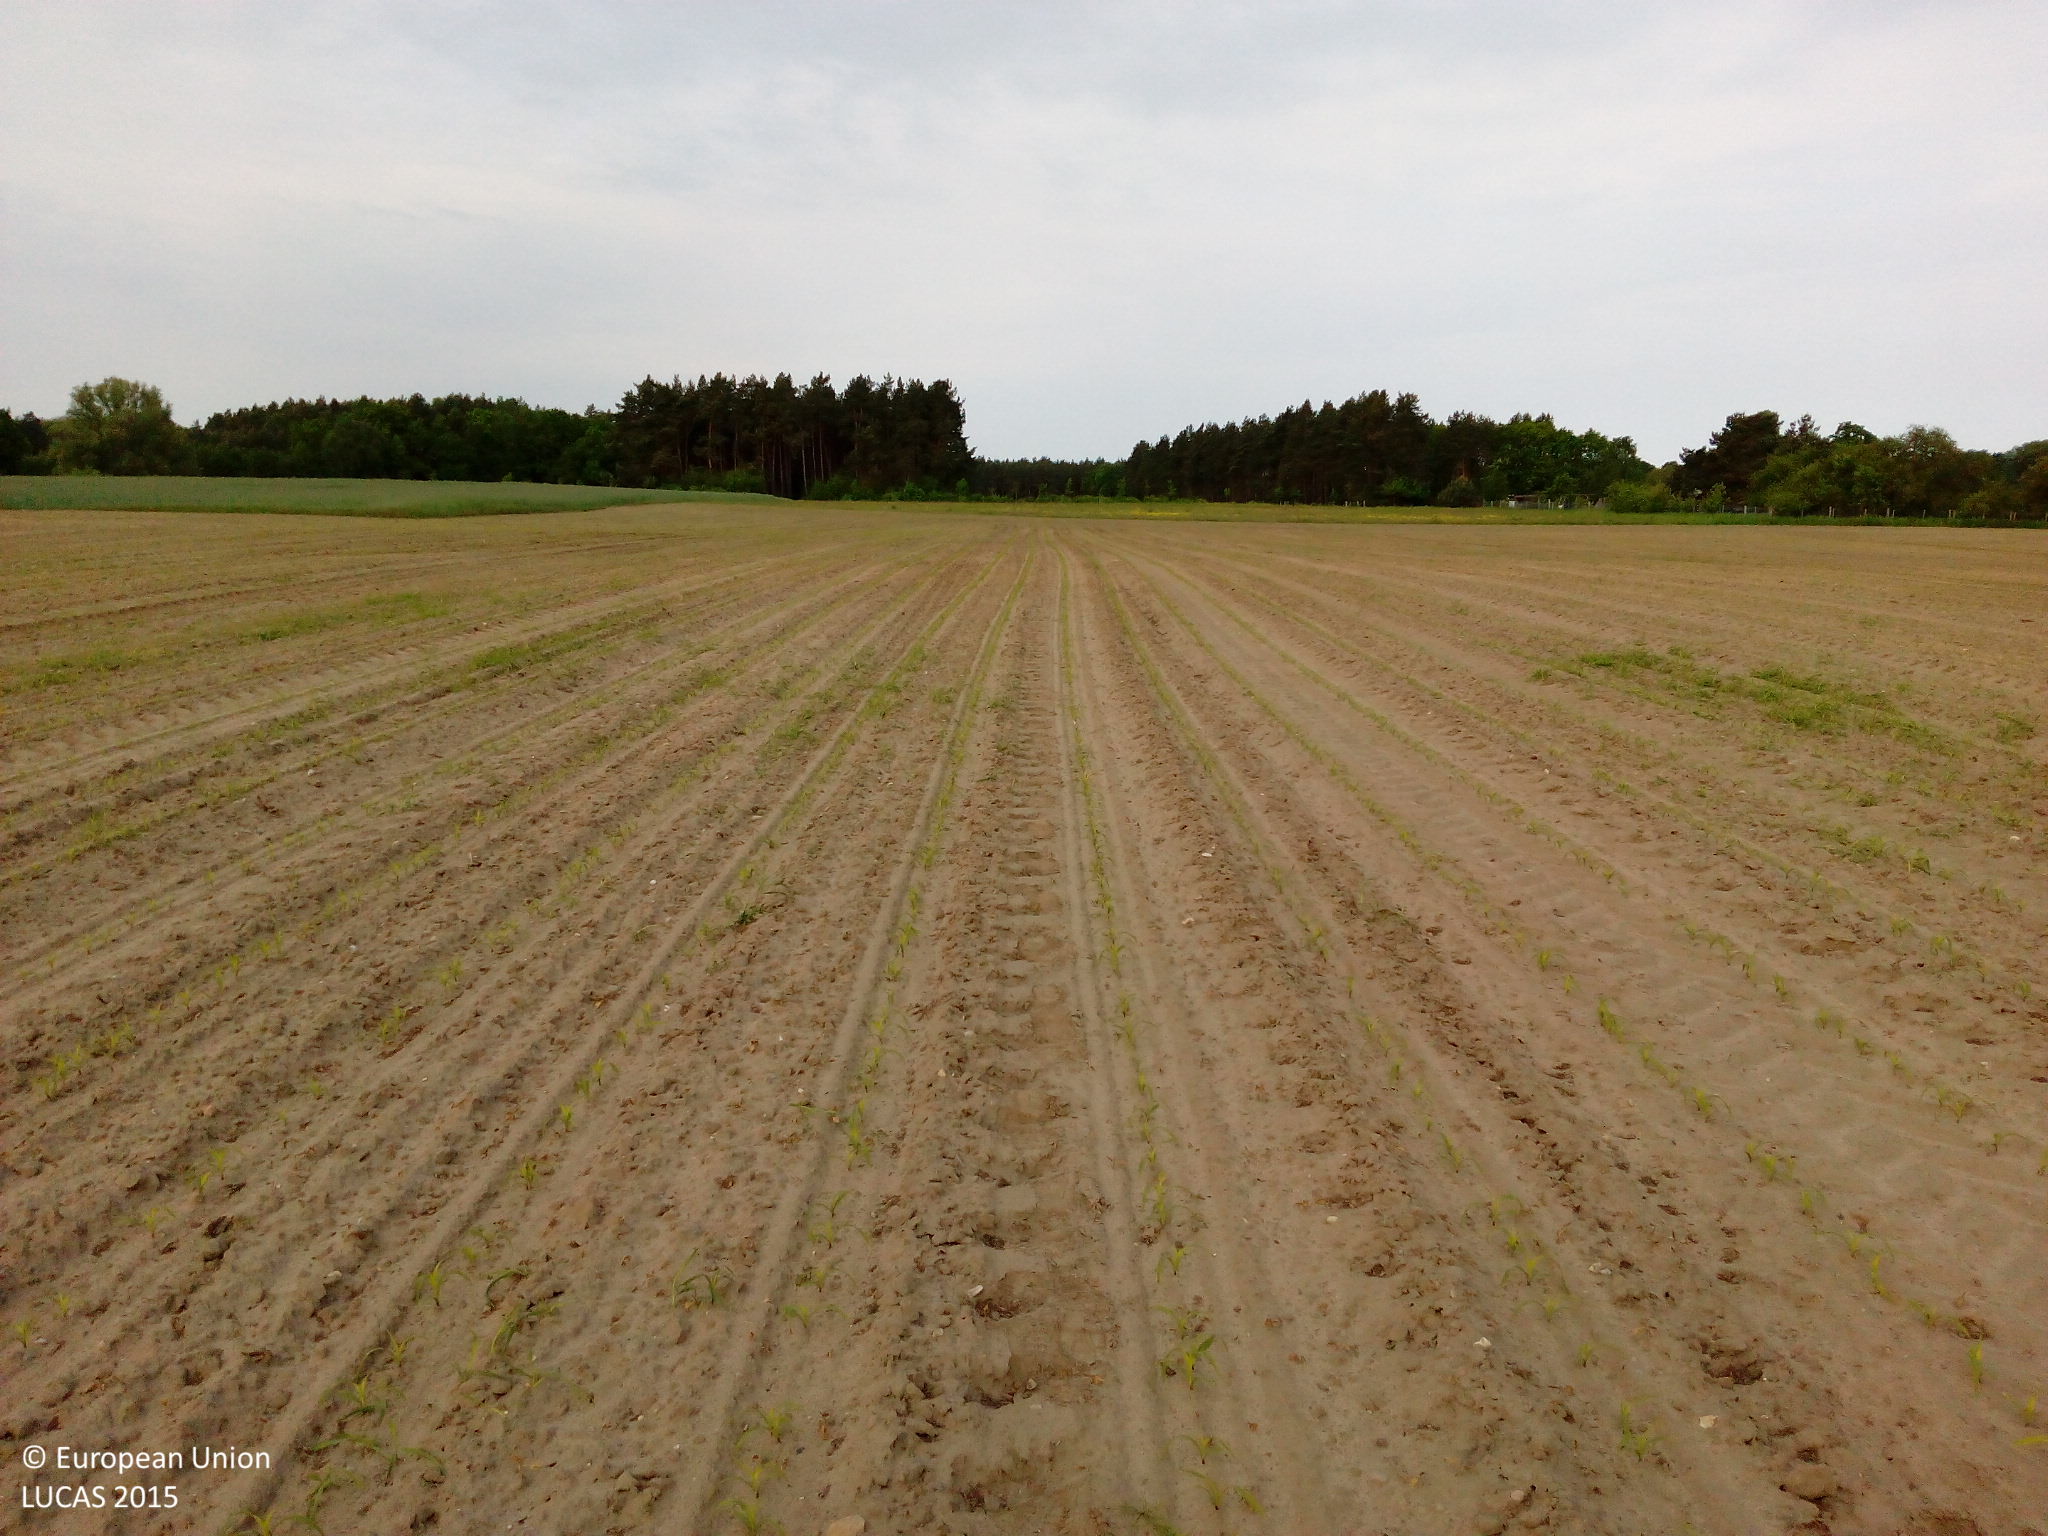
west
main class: Cropland
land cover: Maize
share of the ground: < 10 %
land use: Agriculture (excluding fallow land and kitchen gardens)
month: May
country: DE
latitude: 52.8214
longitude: 11.1422
